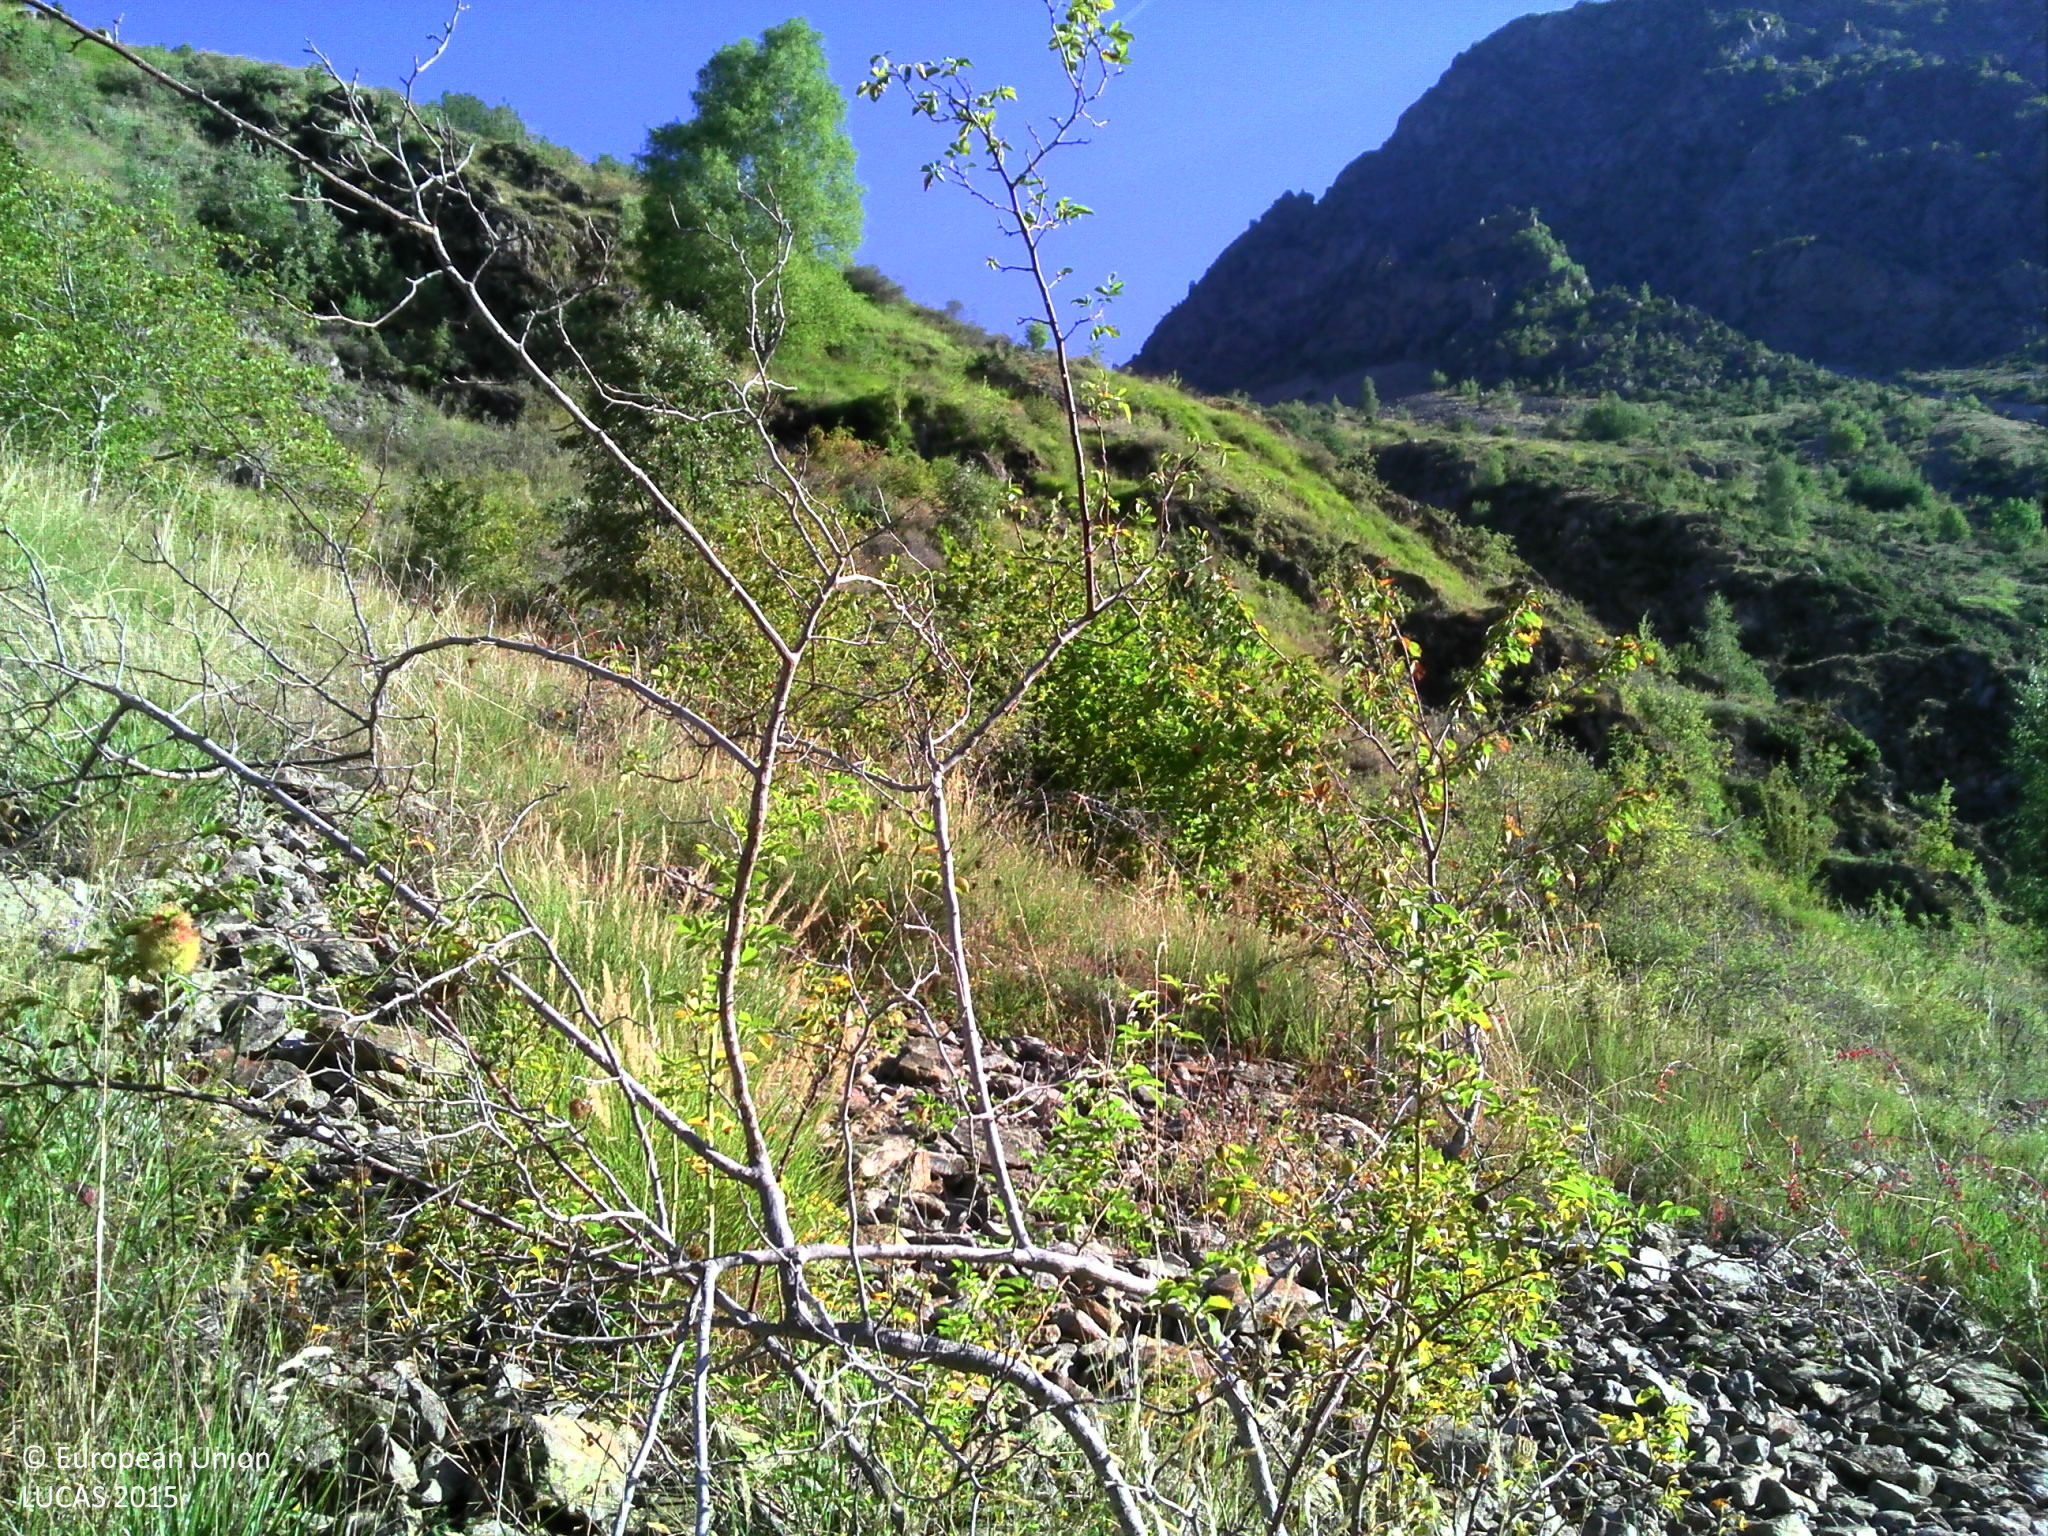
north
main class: Shrubland
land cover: Shrubland with sparse tree cover
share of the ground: > 75 %
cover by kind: consolidated bare surface 60 %, herbaceous plants 20 %, shrubs 15 %, broadleaved forest trees 5 %
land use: Semi-natural and natural areas not in use
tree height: > 5 m
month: August
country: FR
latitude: 44.8225
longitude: 6.1993
